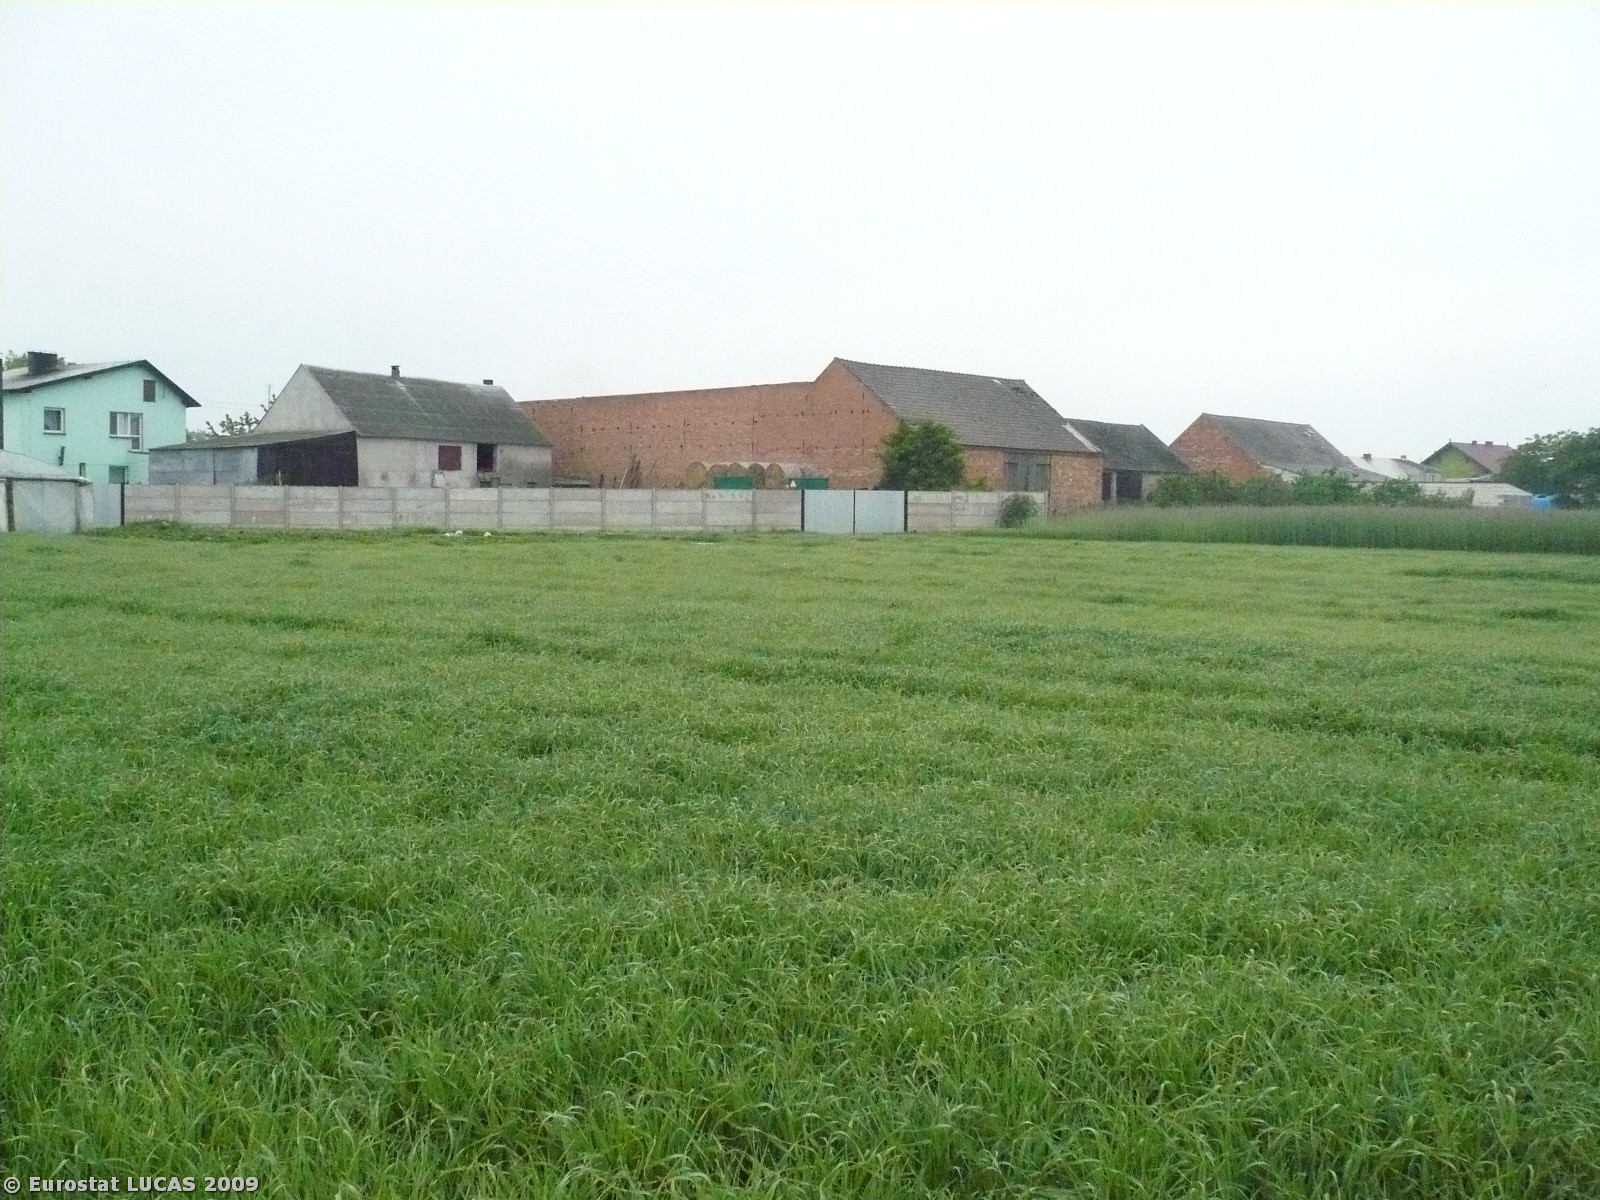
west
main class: Grassland
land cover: Grassland without tree/shrub cover
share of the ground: > 75 %
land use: Agriculture (excluding fallow land and kitchen gardens)
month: May
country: PL
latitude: 52.1915
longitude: 16.3117
